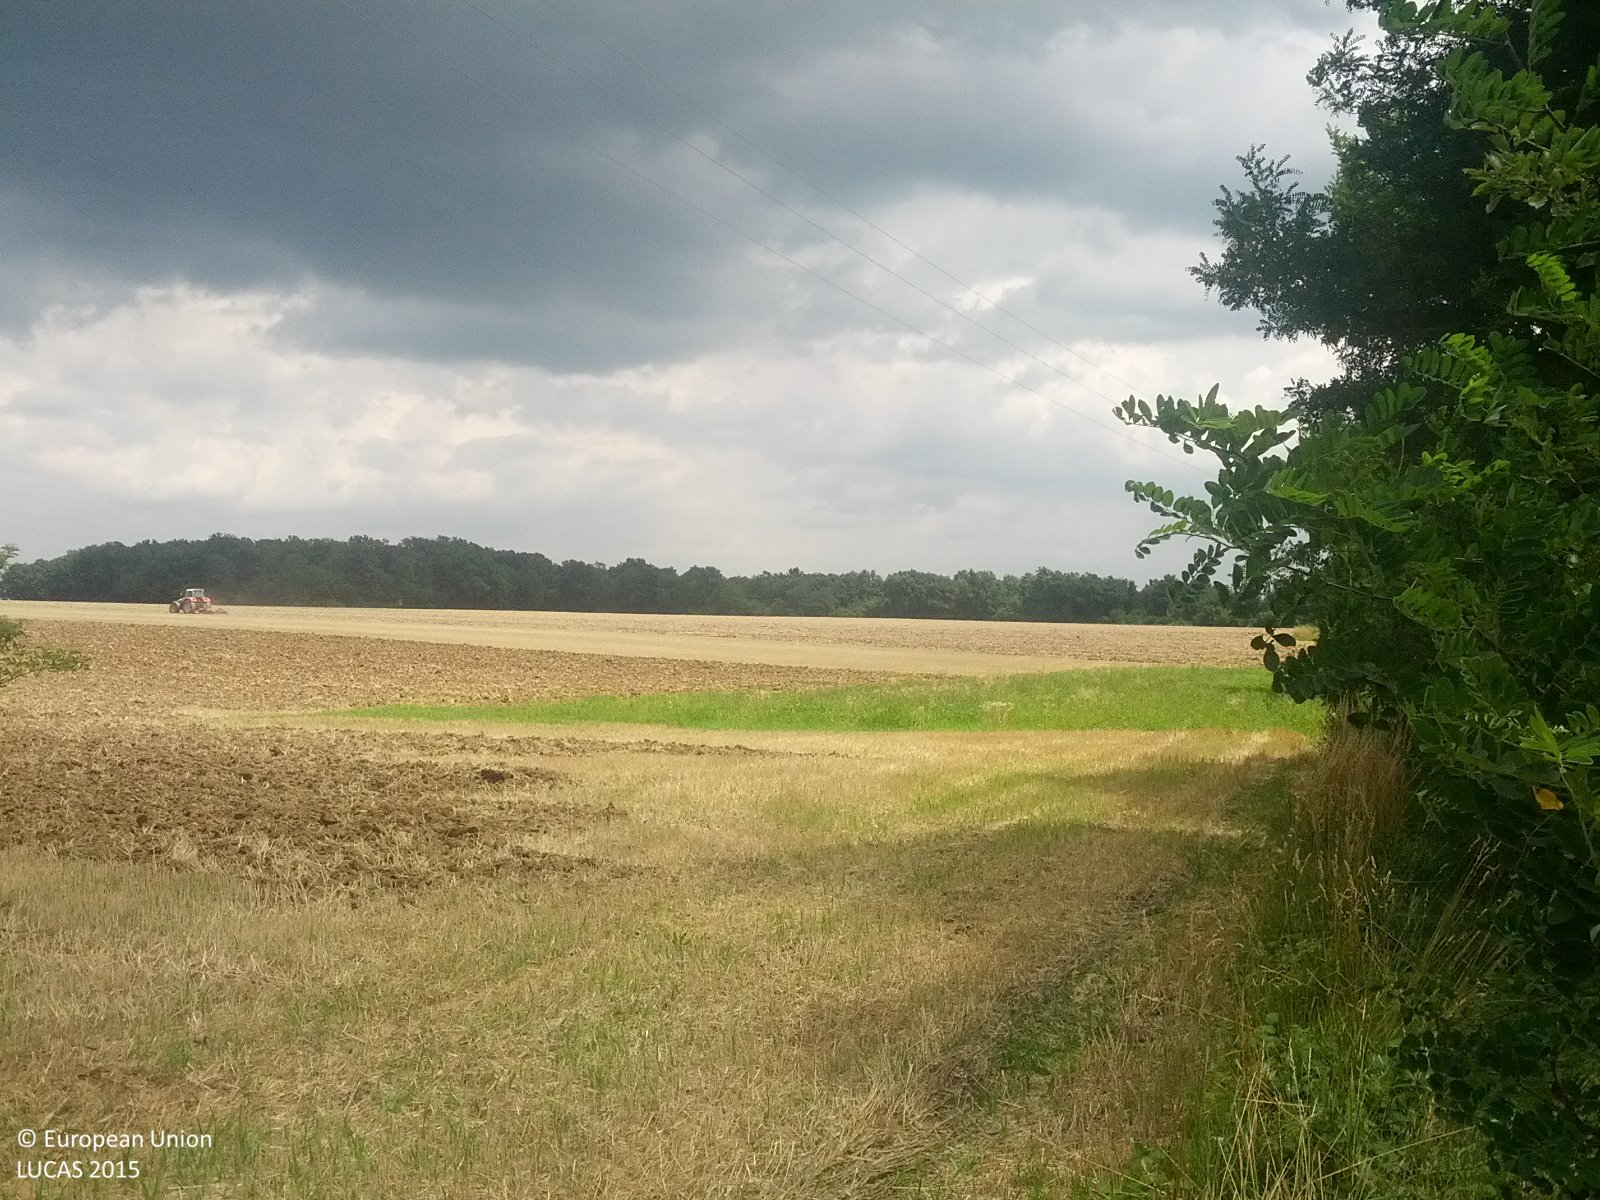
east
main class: Cropland
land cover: Common wheat
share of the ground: > 75 %
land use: Agriculture (excluding fallow land and kitchen gardens)
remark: Harvested field
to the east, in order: Grass margins; Common wheat; Electric lines; Common wheat
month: July
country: AT
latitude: 47.2574
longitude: 16.4650
